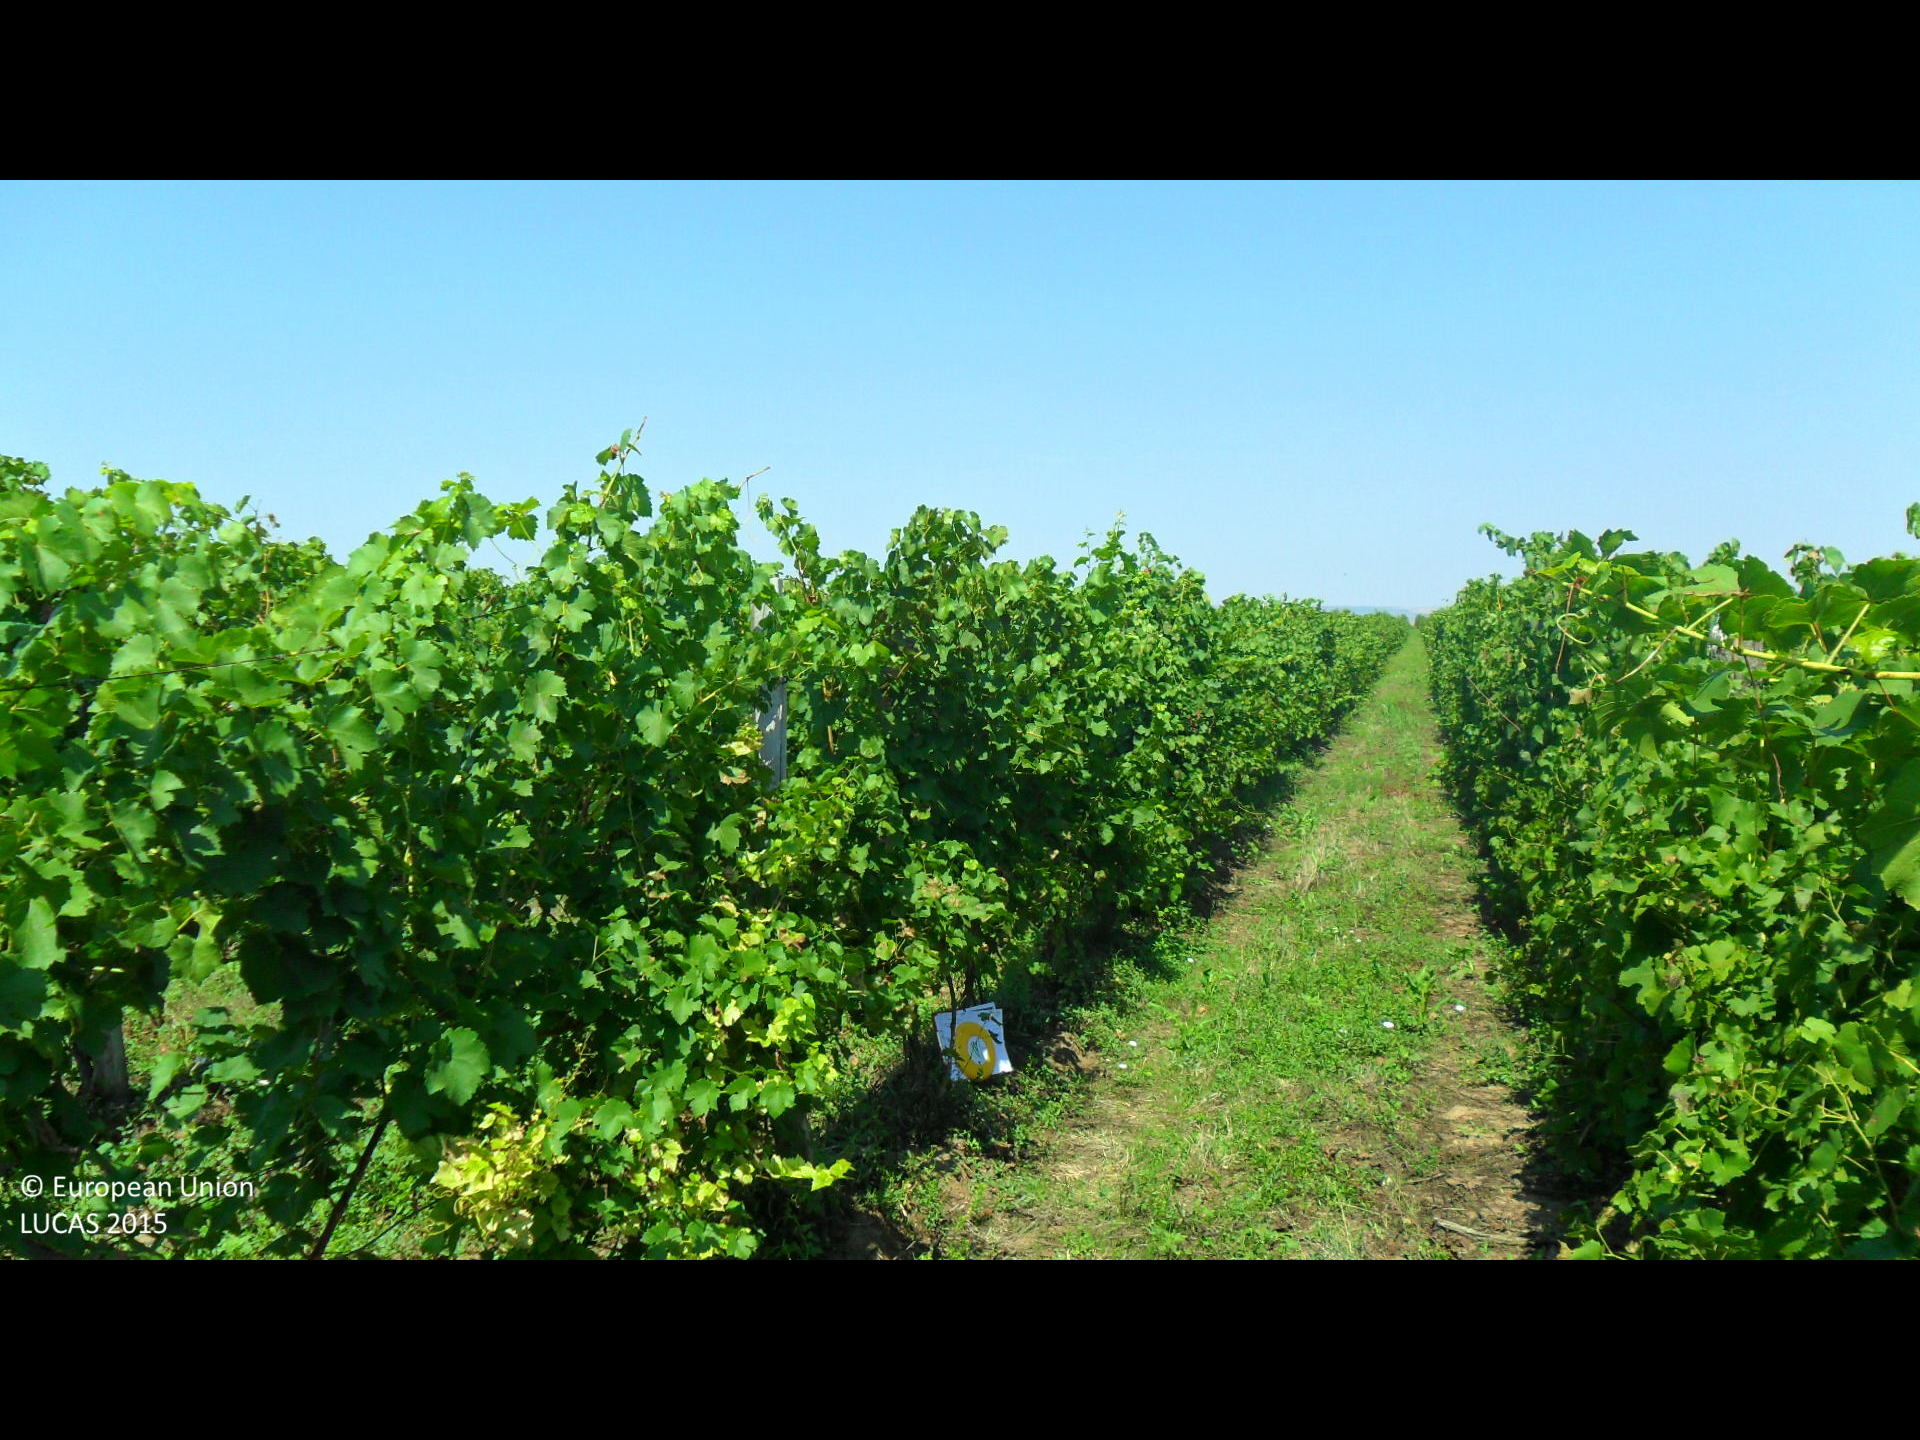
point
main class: Cropland
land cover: Vineyards
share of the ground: > 75 %
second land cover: Grassland without tree/shrub cover
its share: 25 - 50 %
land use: Agriculture (excluding fallow land and kitchen gardens)
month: August
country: BG
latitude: 43.2142
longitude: 26.7626
